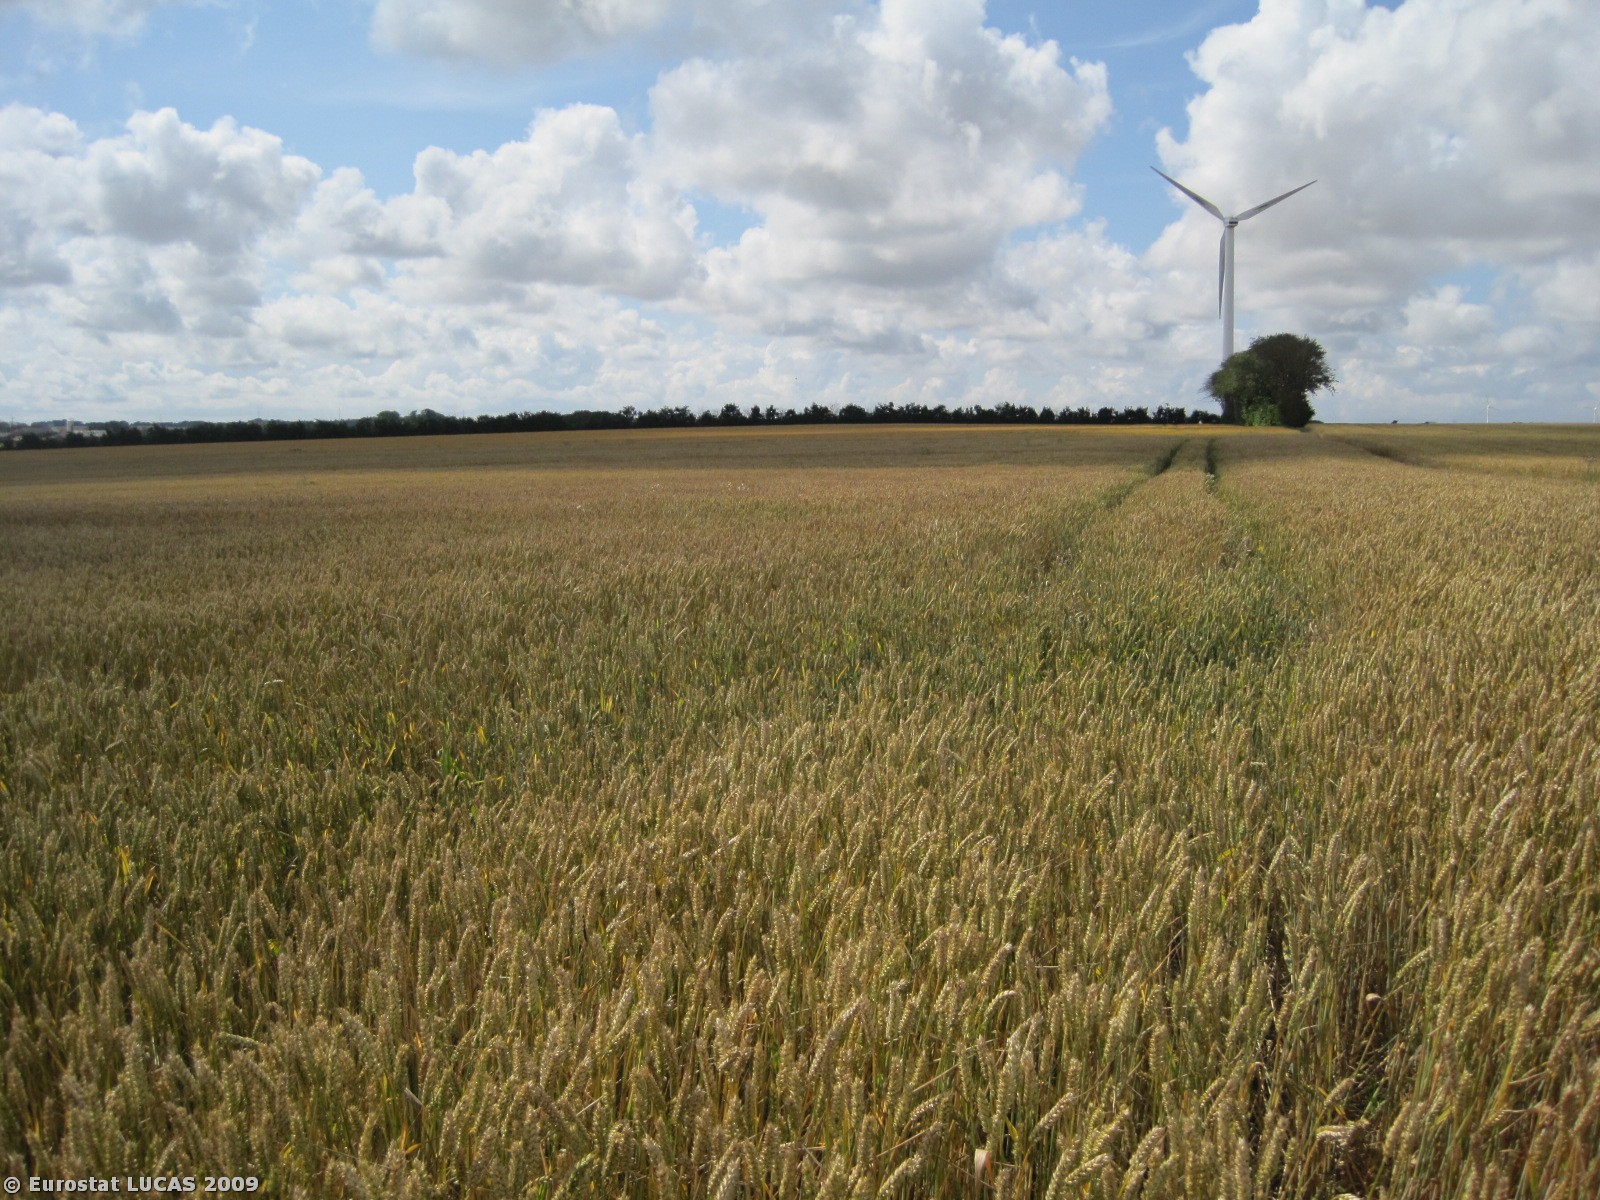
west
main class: Cropland
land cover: Common wheat
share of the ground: > 75 %
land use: Agriculture (excluding fallow land and kitchen gardens)
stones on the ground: 25 - 50 %
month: July
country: DK
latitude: 56.9903
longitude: 8.7017
